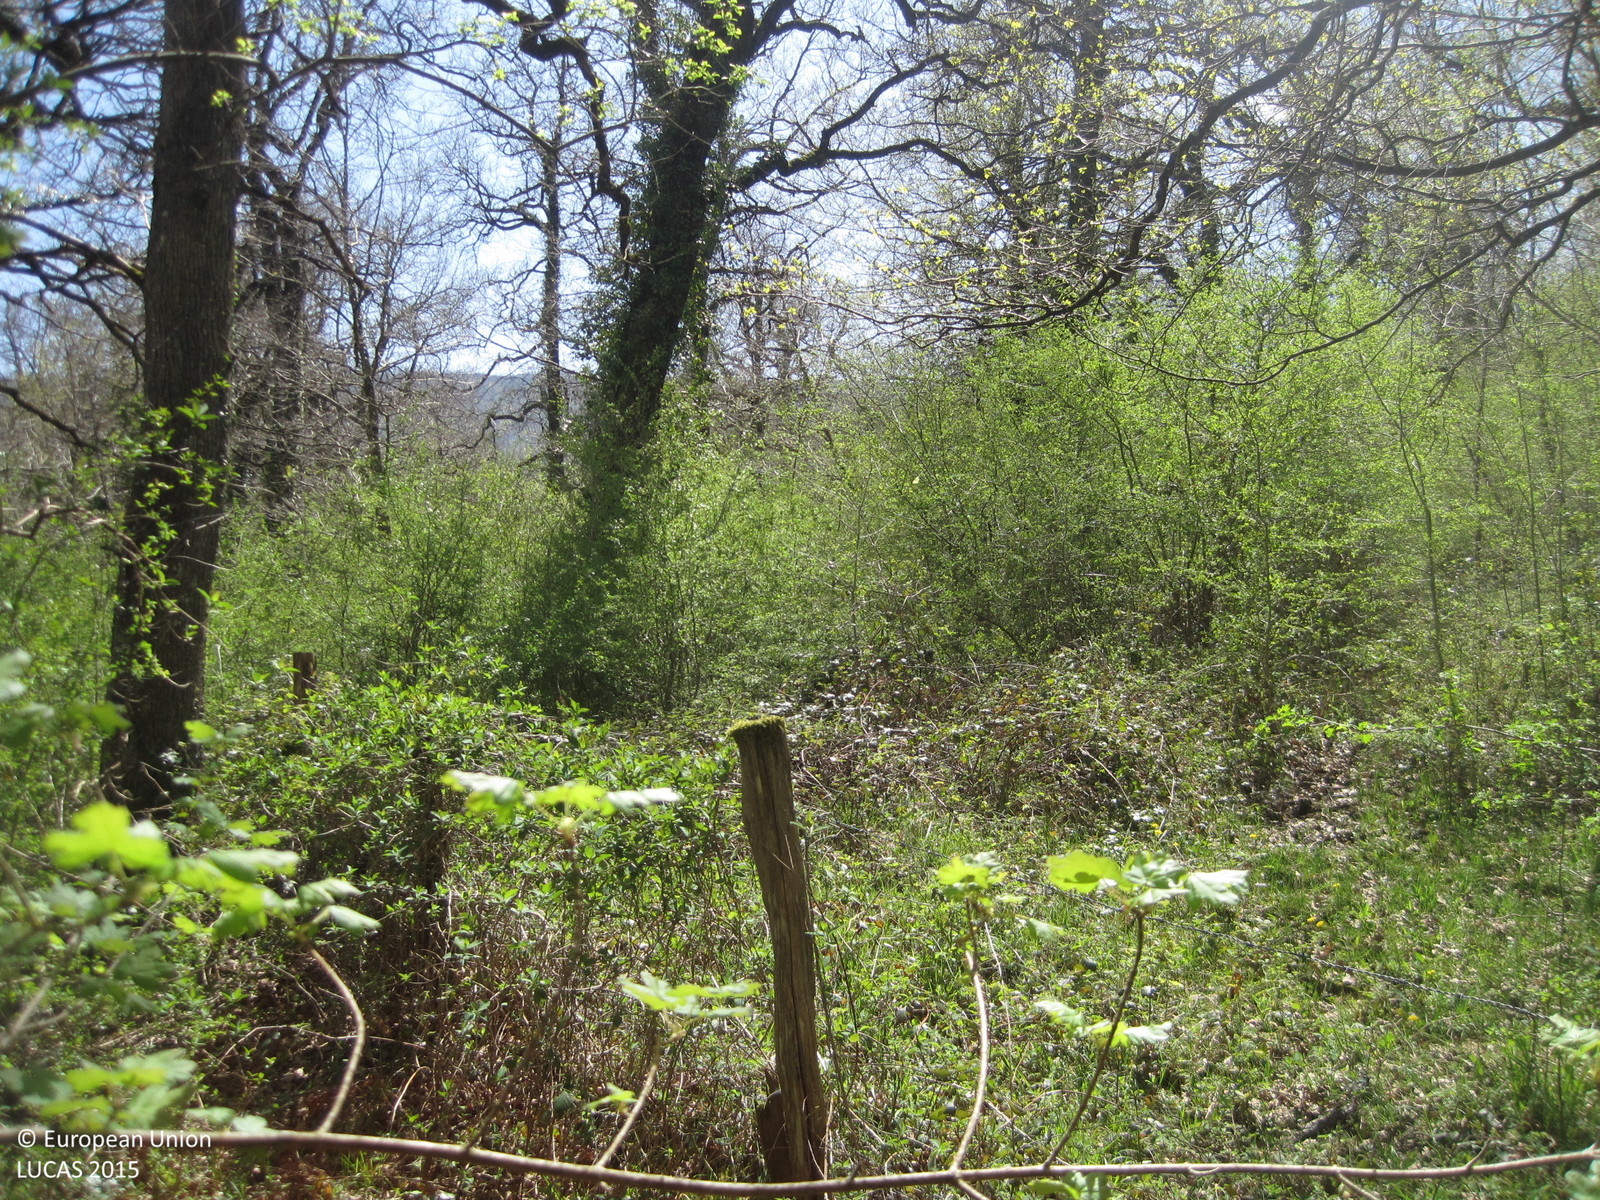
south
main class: Woodland
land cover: Broadleaved woodland
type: acidophilous oak and oak-birch forest
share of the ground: > 75 %
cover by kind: broadleaved forest trees 100 %
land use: Forestry
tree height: > 5 m
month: April
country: ES
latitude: 42.8770
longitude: -2.2272
